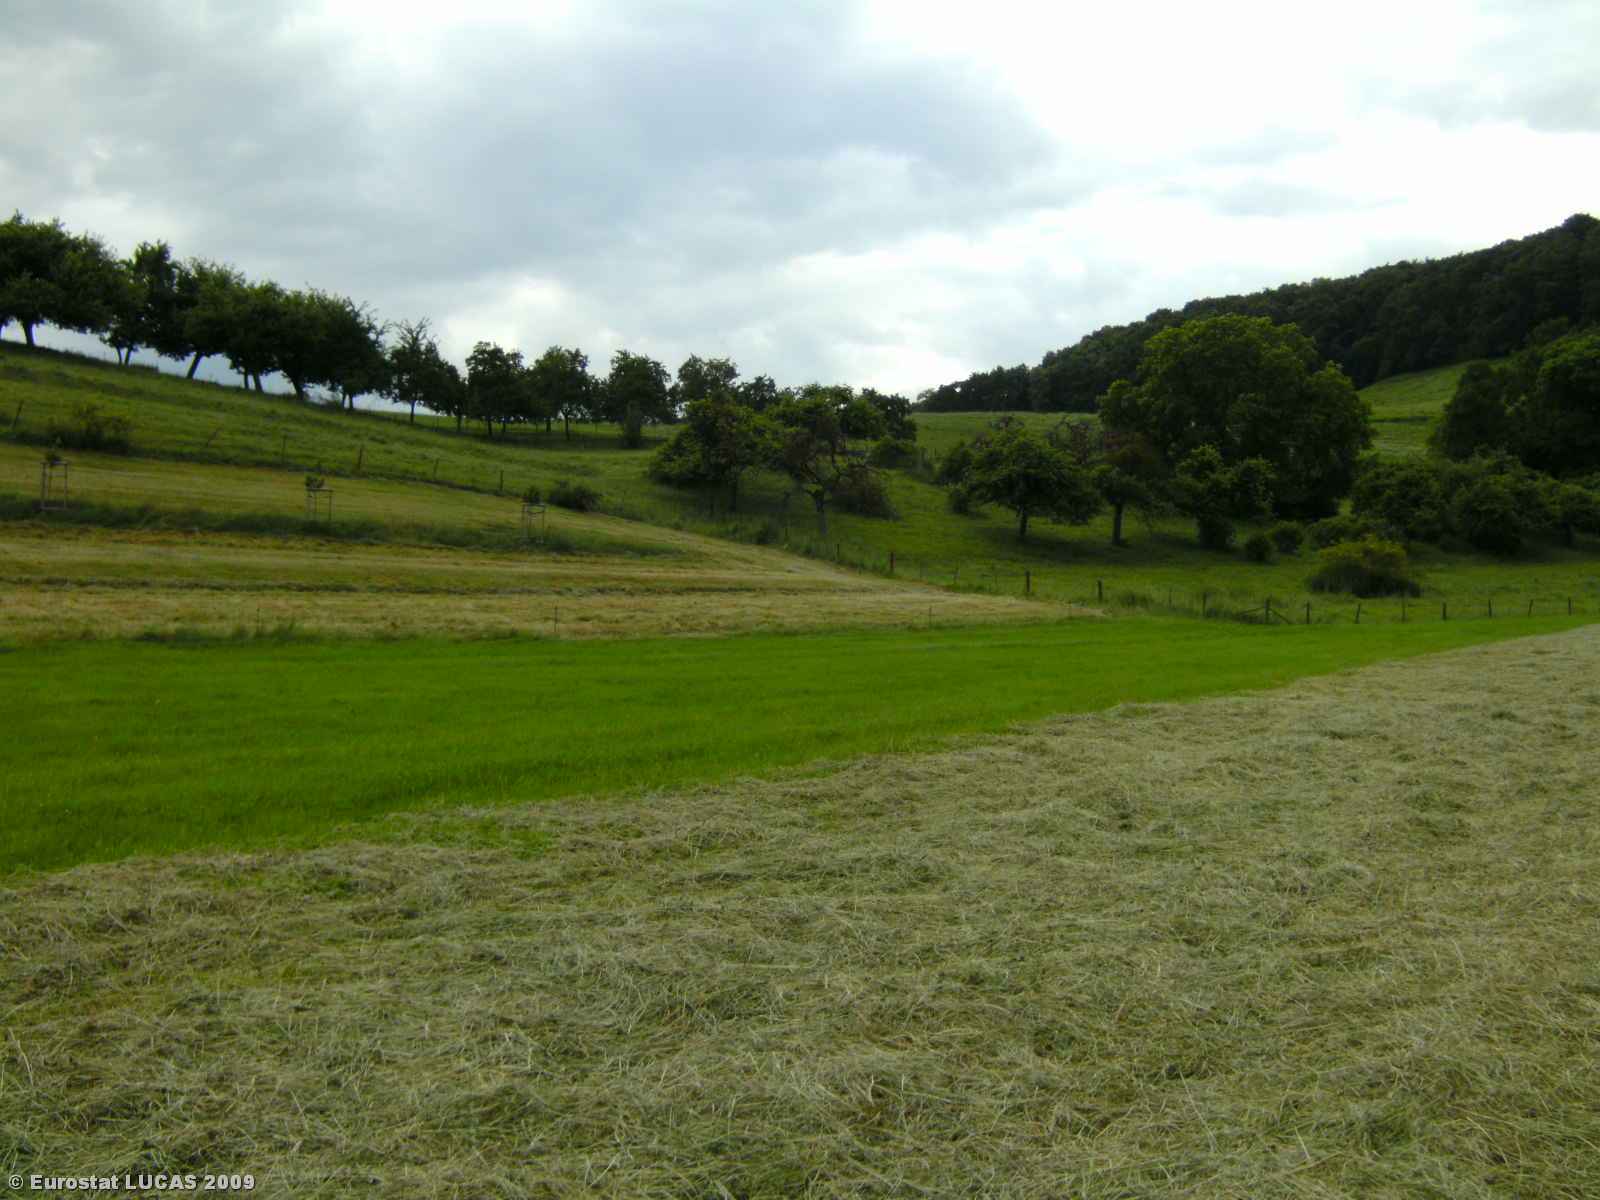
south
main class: Grassland
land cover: Grassland without tree/shrub cover
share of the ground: > 75 %
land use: Agriculture (excluding fallow land and kitchen gardens)
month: June
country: LU
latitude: 49.5655
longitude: 6.2803
